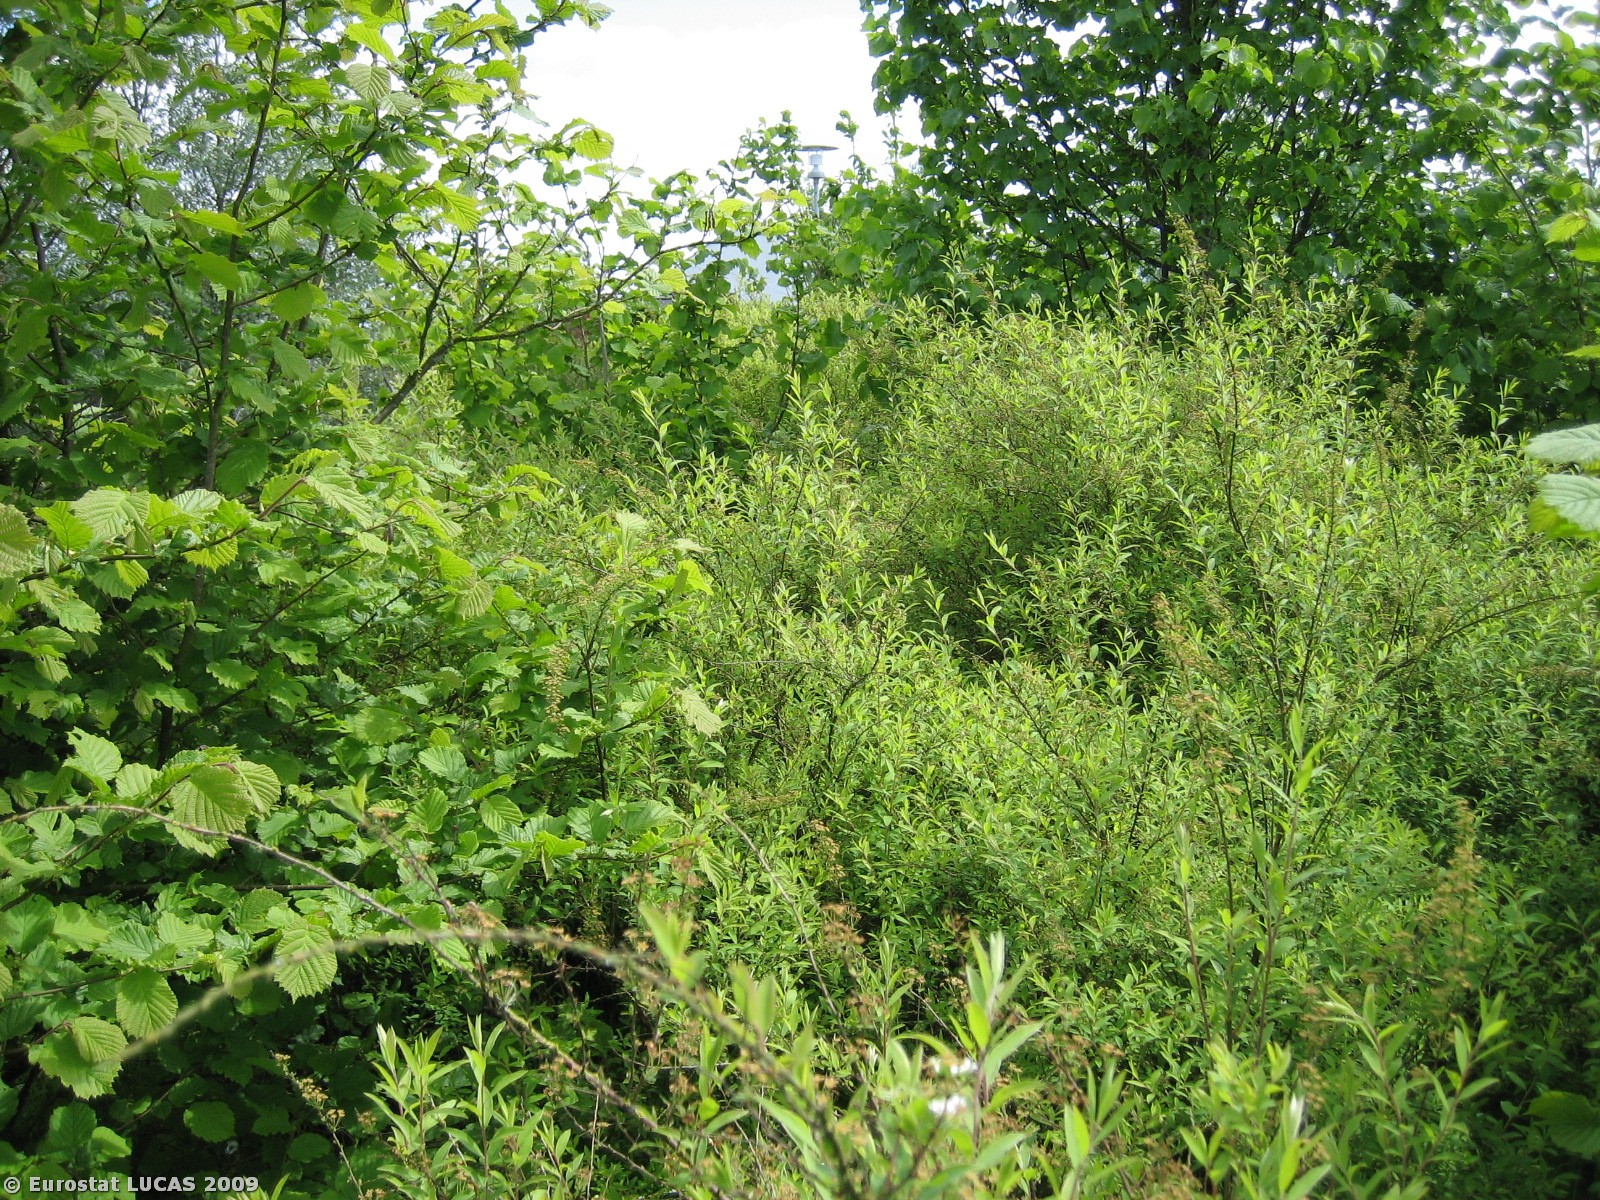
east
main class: Shrubland
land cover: Shrubland with sparse tree cover
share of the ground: > 75 %
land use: Amenities, museums, leisure
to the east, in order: Shrubland with sparse tree cover; Grass margins; Tracks; Grass margins; Shrubland with sparse tree cover; Managed hedges; Artificial constructions in urban areas
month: May
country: DK
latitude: 56.1118
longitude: 8.9880
